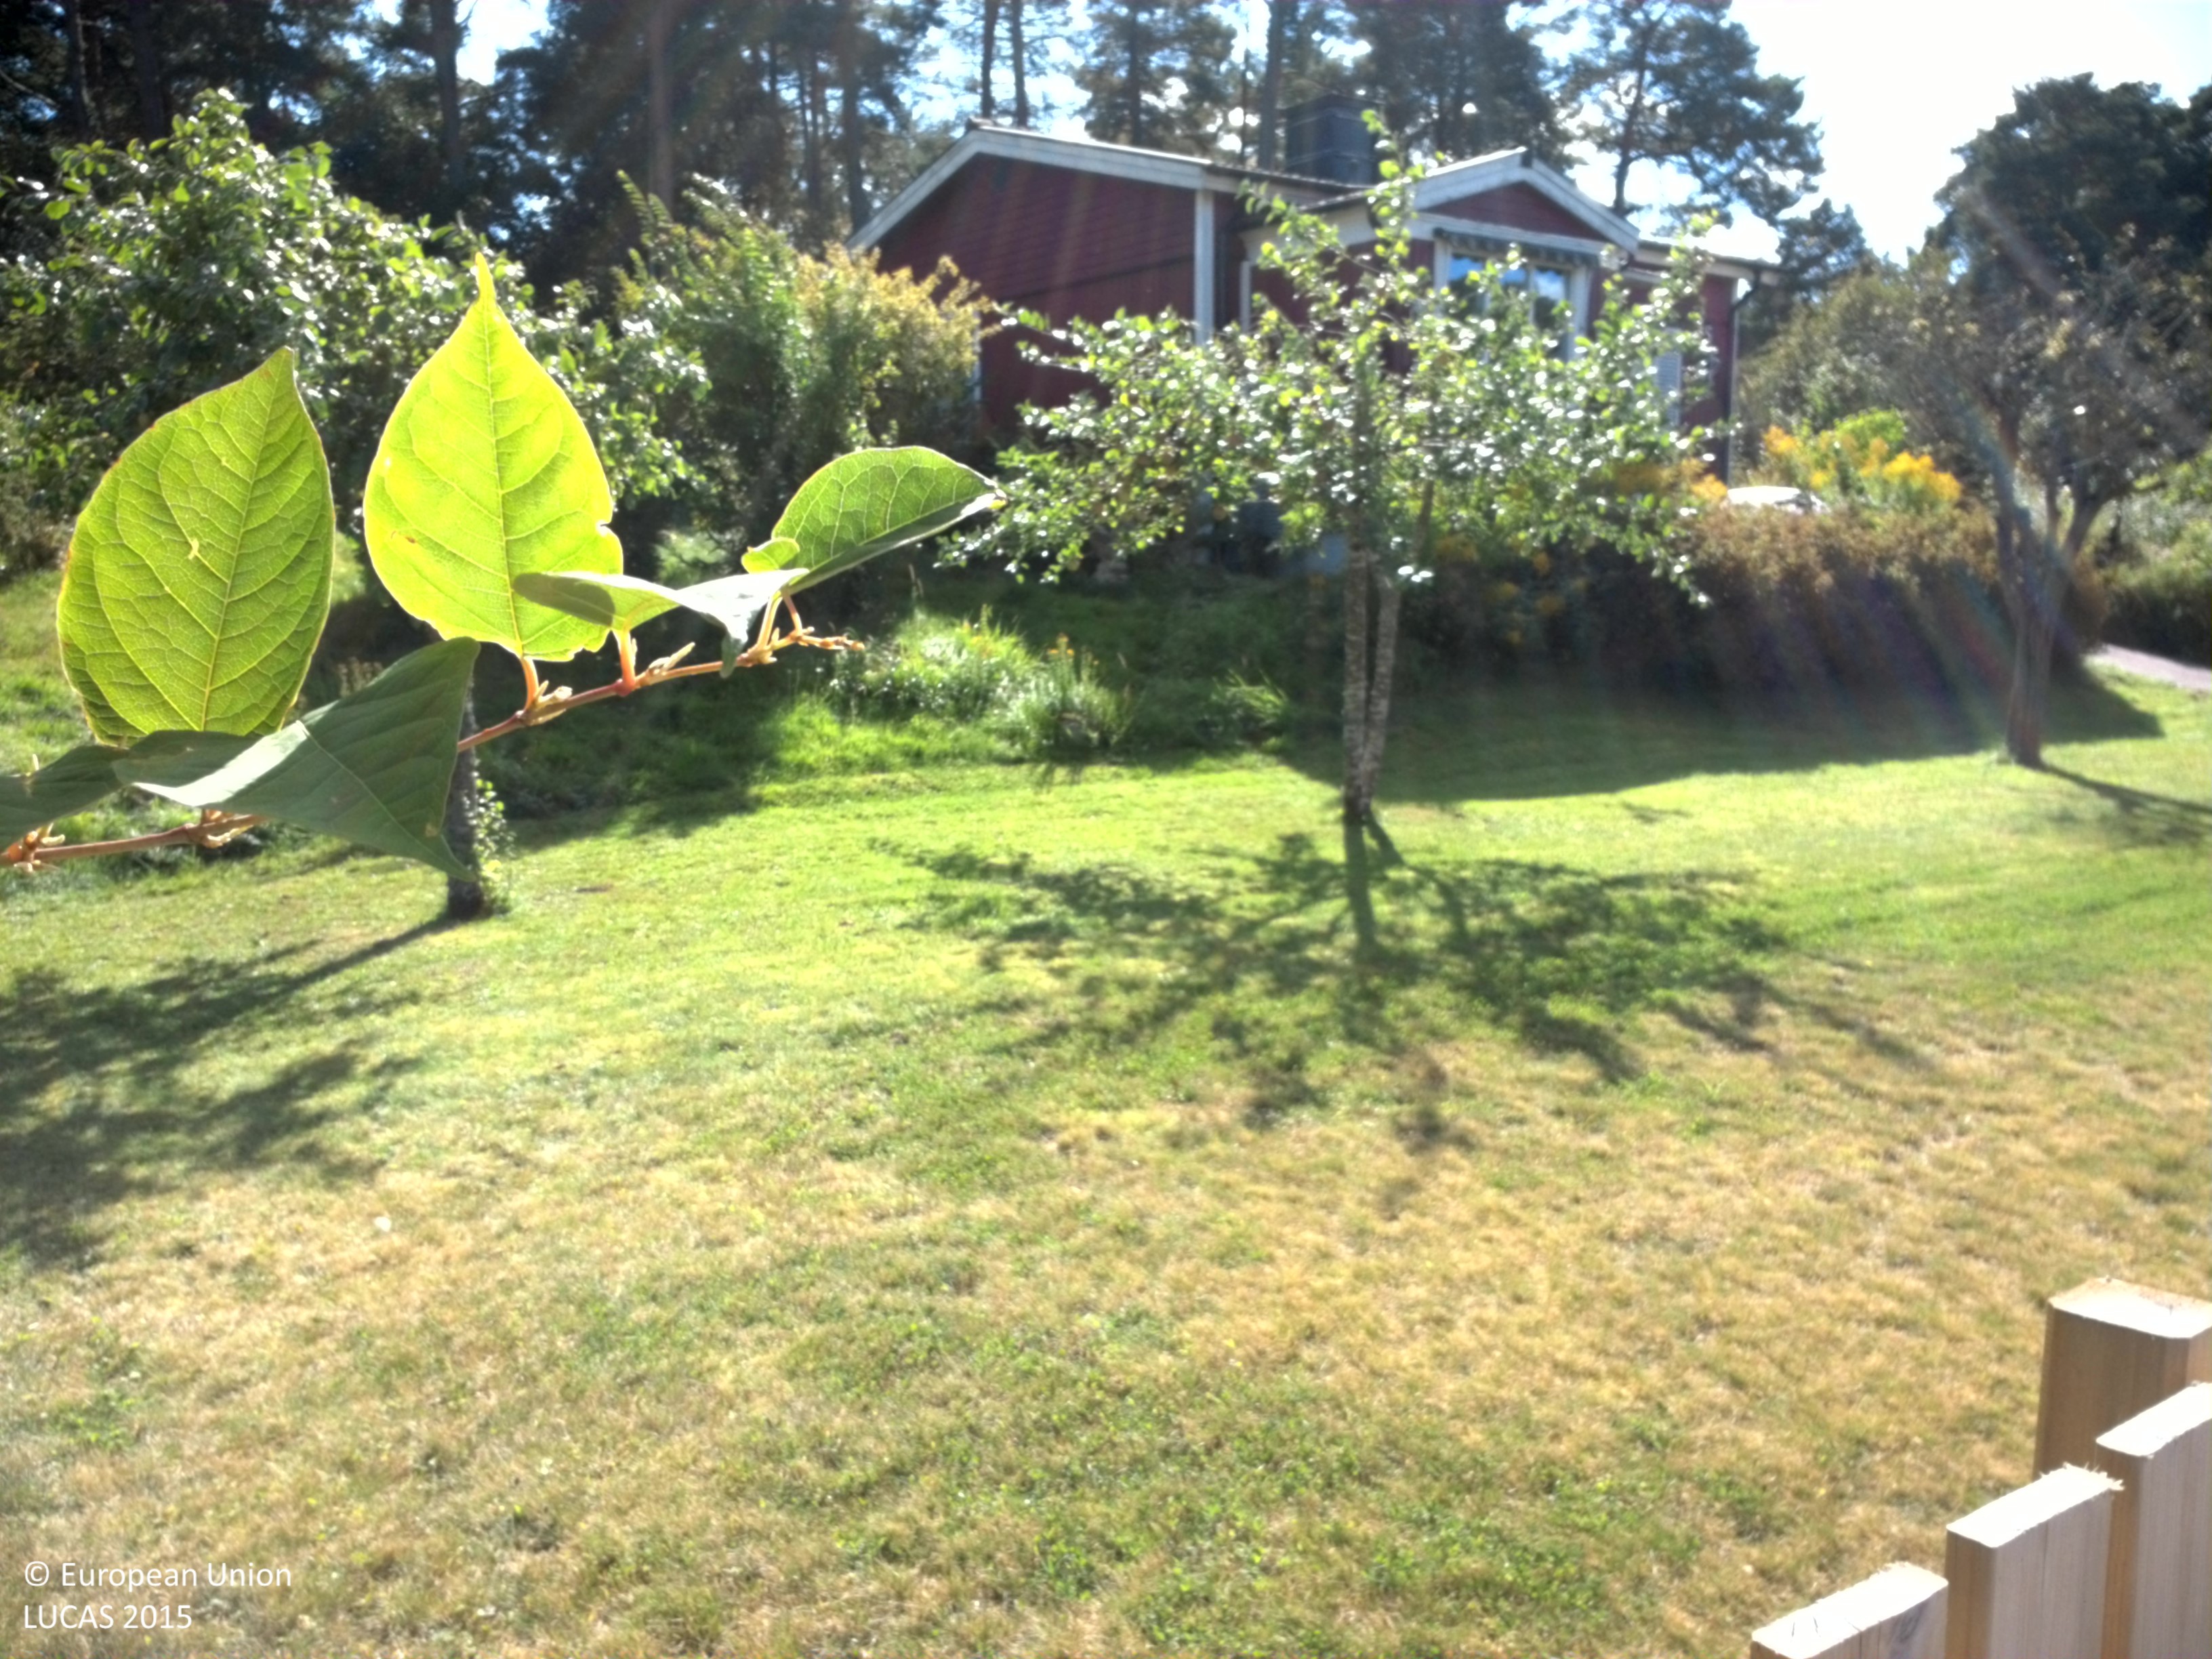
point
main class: Grassland
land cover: Grassland with sparse tree/shrub cover
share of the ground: > 75 %
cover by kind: herbaceous plants 95 %, broadleaved forest trees 5 %
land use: Residential
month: August
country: SE
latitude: 59.6399
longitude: 17.1063
